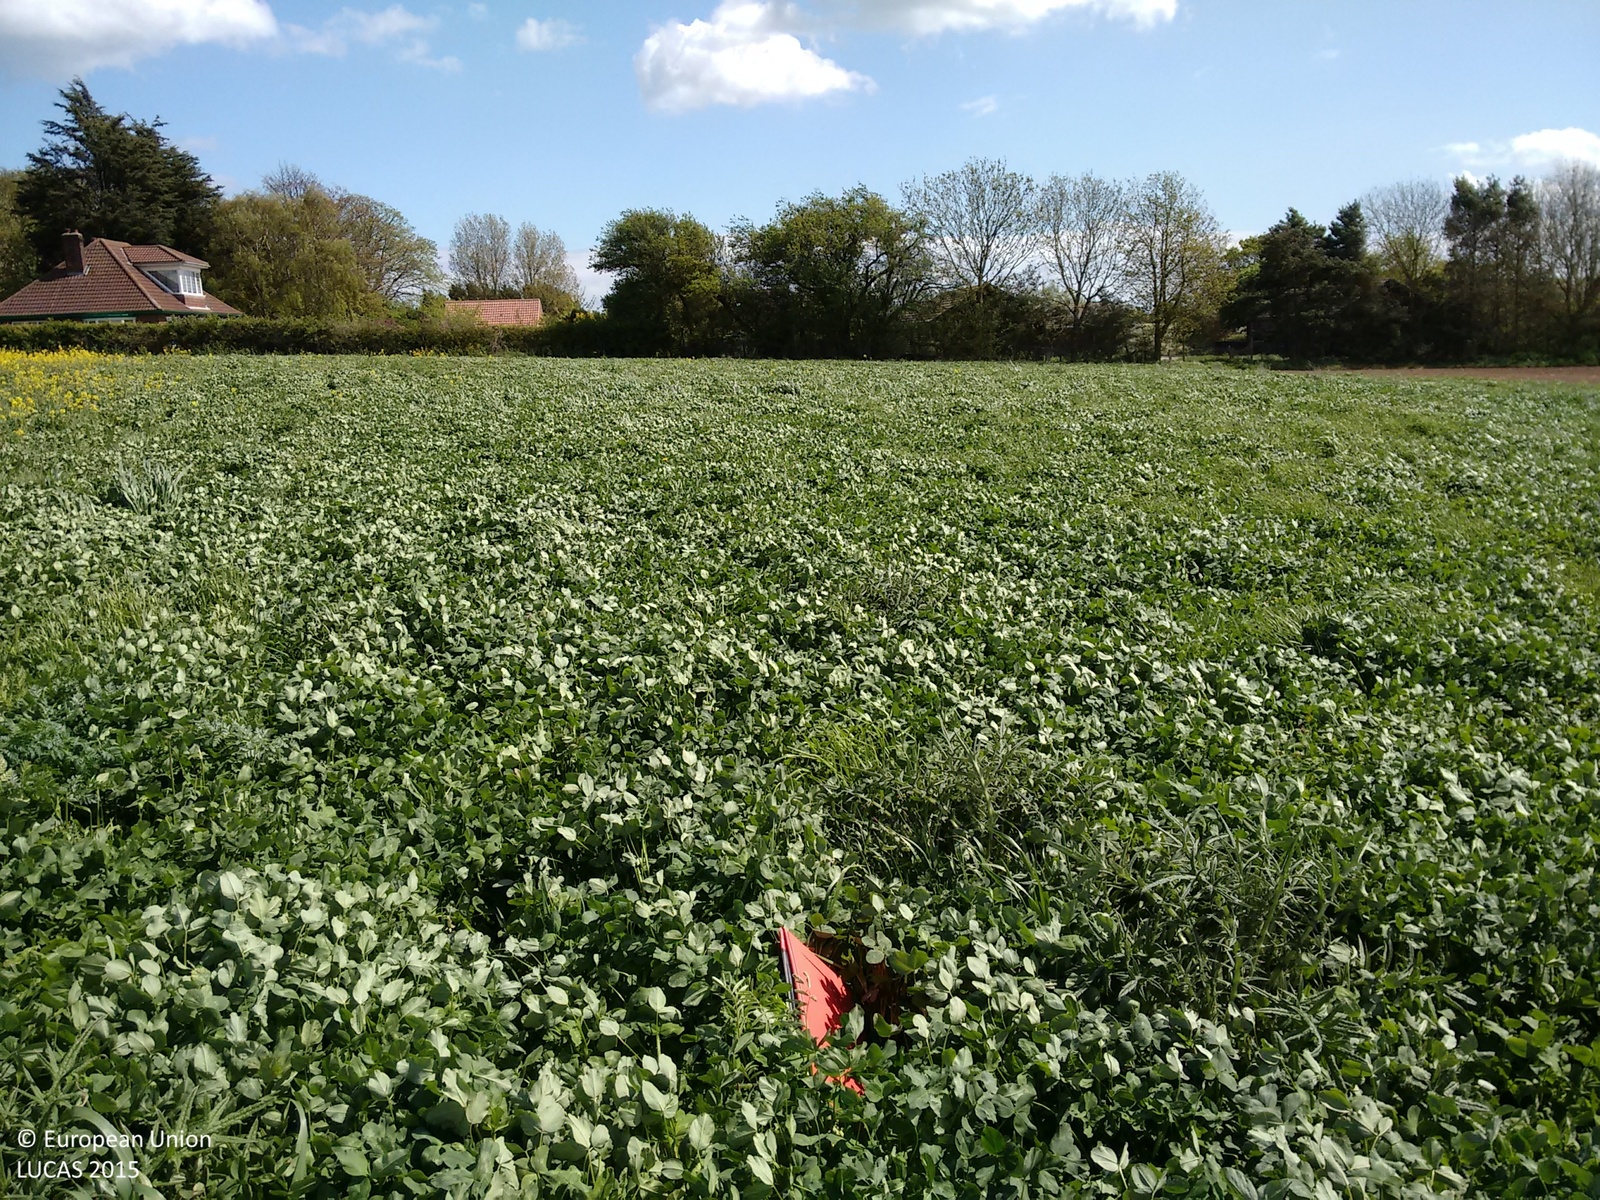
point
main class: Cropland
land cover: Clovers
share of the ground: > 75 %
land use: Agriculture (excluding fallow land and kitchen gardens)
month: May
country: GB
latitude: 53.8782
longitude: -0.1790
